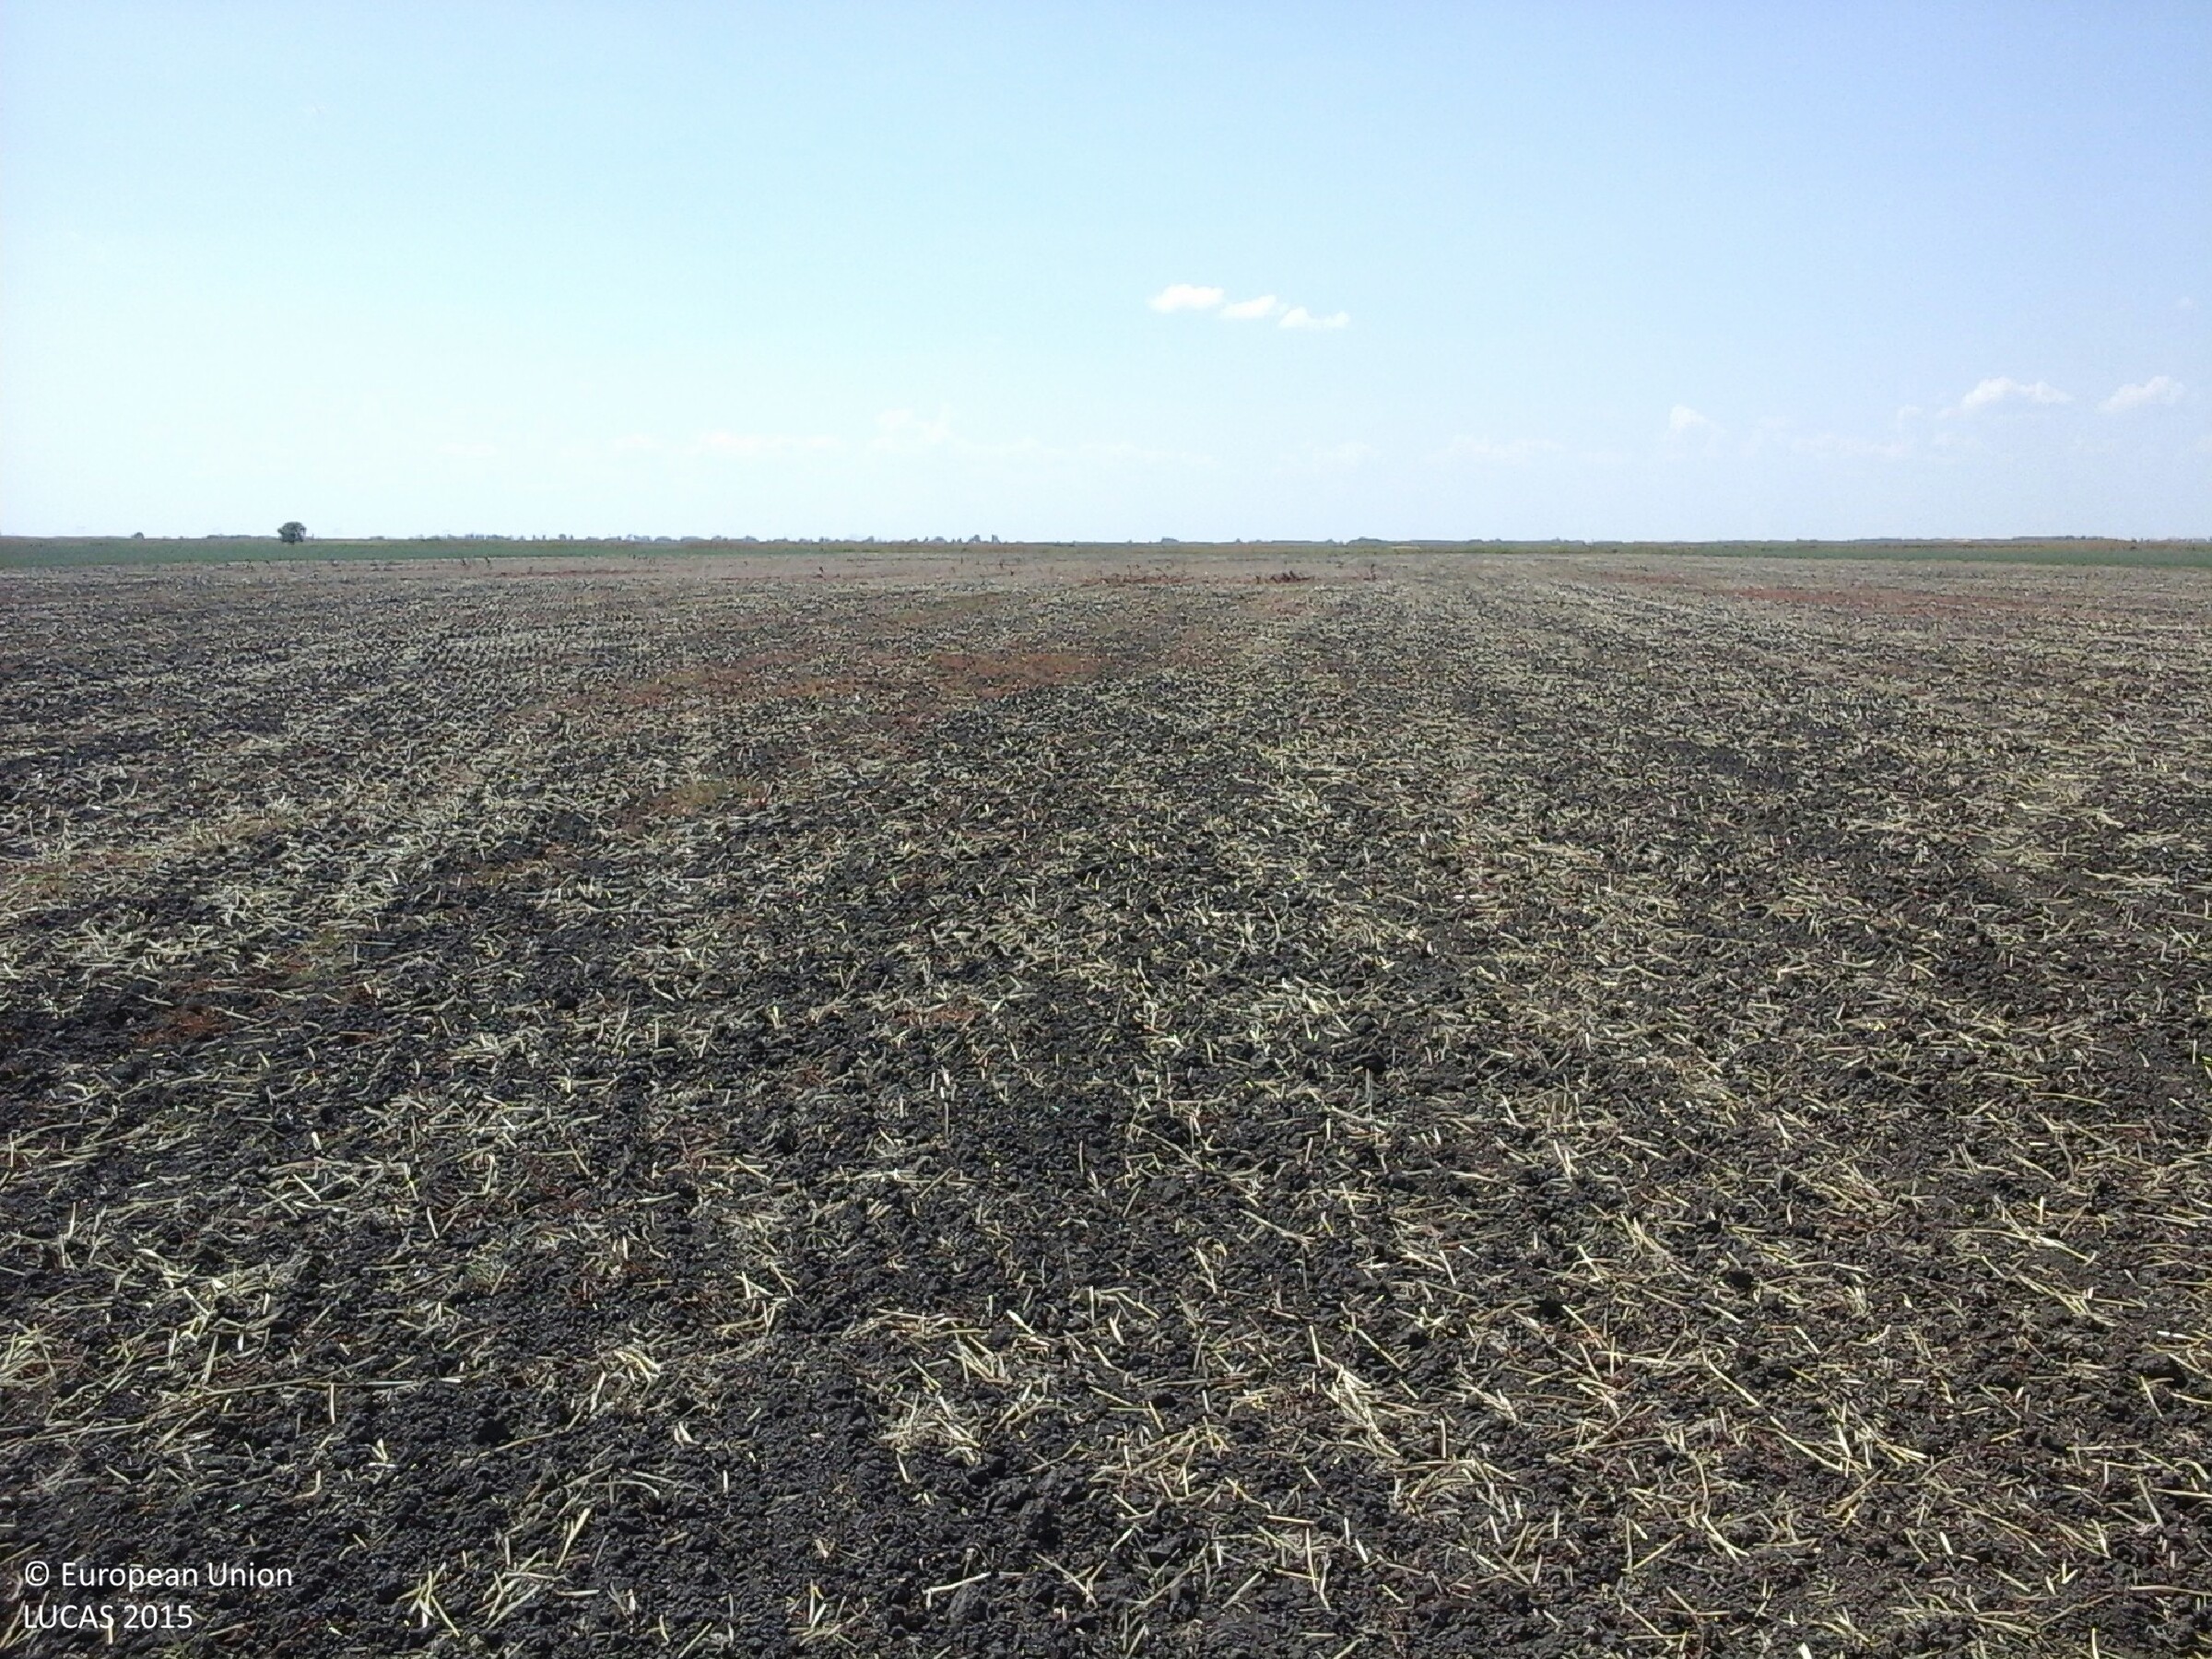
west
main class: Cropland
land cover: Common wheat
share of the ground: < 10 %
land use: Agriculture (excluding fallow land and kitchen gardens)
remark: Harvested field
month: August
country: HU
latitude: 47.3817
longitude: 20.9901
